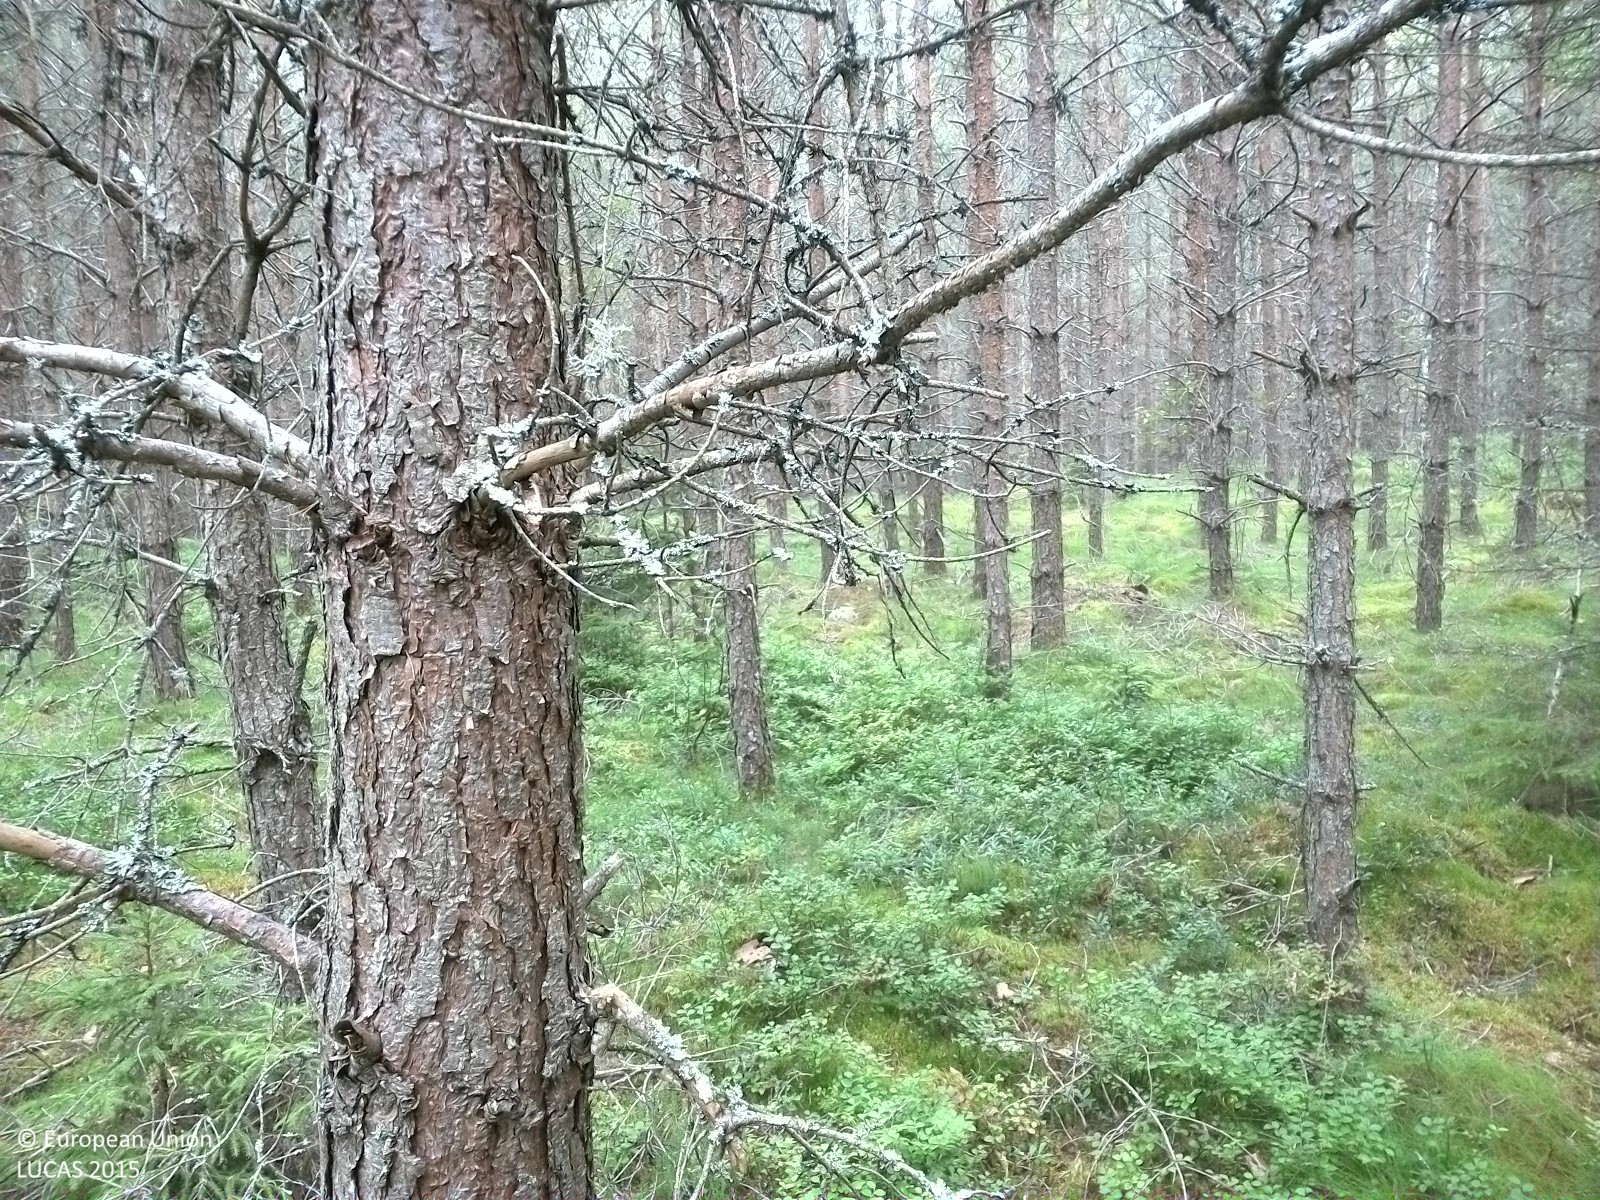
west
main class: Woodland
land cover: Pine dominated coniferous woodland
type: boreal forest
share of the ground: 25 - 50 %
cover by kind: herbaceous plants 45 %, coniferous forest trees 35 %, lichens and mosses 20 %
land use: Forestry
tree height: > 5 m
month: August
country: SE
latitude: 59.1313
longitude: 14.6225
